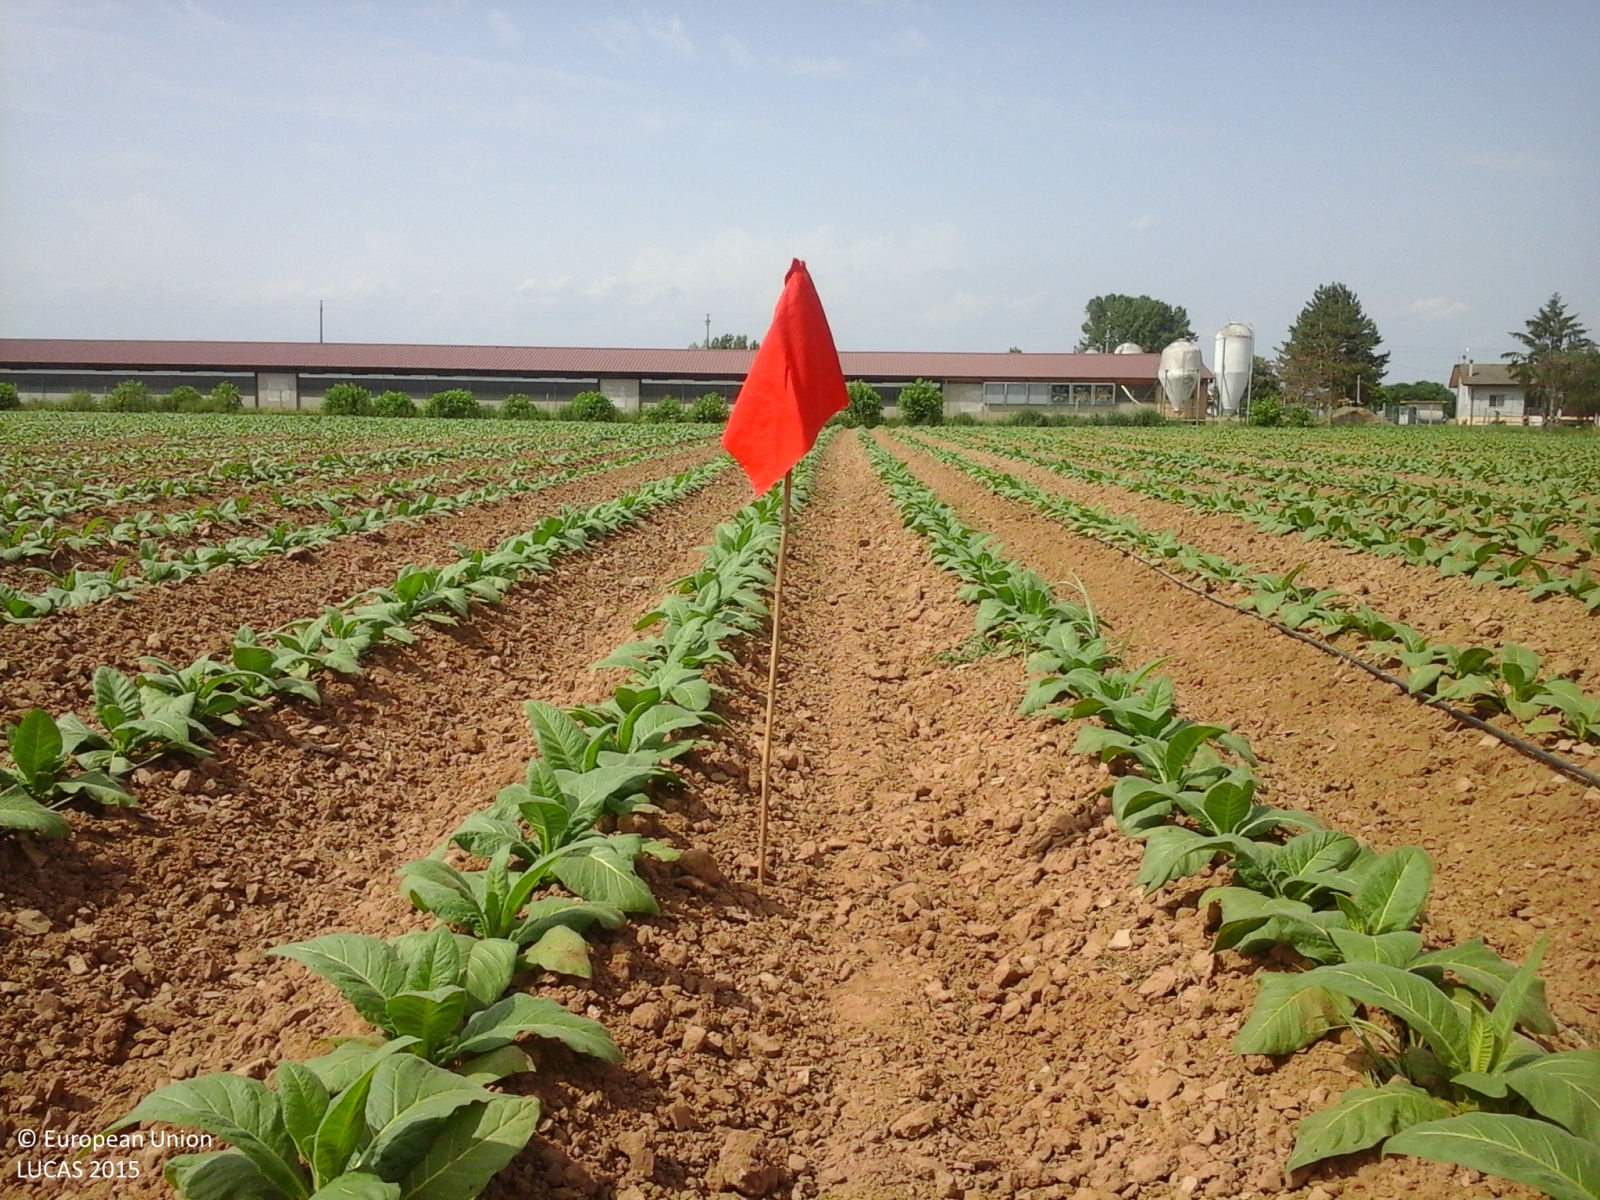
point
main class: Cropland
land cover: Tobacco
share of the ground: 10 - 25 %
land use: Agriculture (excluding fallow land and kitchen gardens)
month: June
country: IT
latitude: 45.2634
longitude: 11.1831
